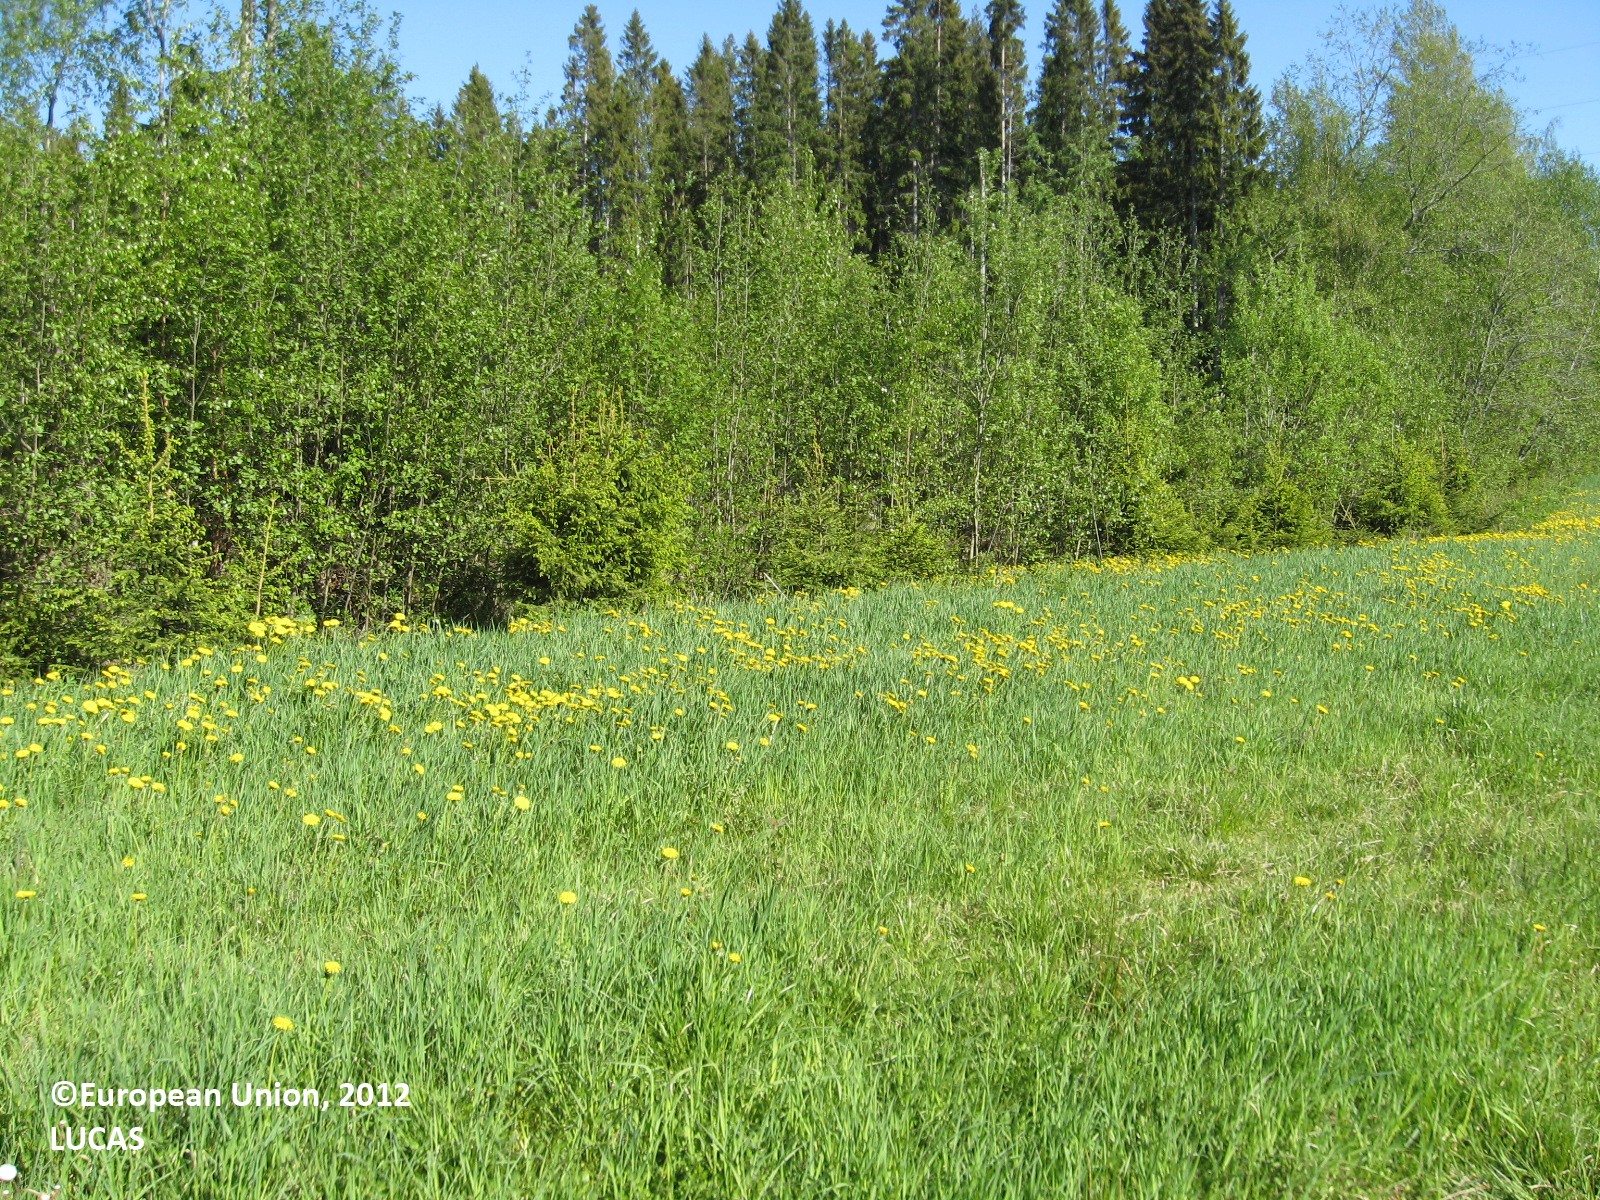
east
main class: Grassland
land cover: Grassland without tree/shrub cover
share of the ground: > 75 %
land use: Agriculture (excluding fallow land and kitchen gardens)
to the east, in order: Grassland without tree/shrub cover; Ditches and canals; Spontaneously vegetated surfaces; Spruce dominated coniferous woodland; Shrubland without tree cover; Ditches and canals; Electric lines; Shrubland without tree cover; Ditches and canals
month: May
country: FI
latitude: 61.7686
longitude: 22.3966
